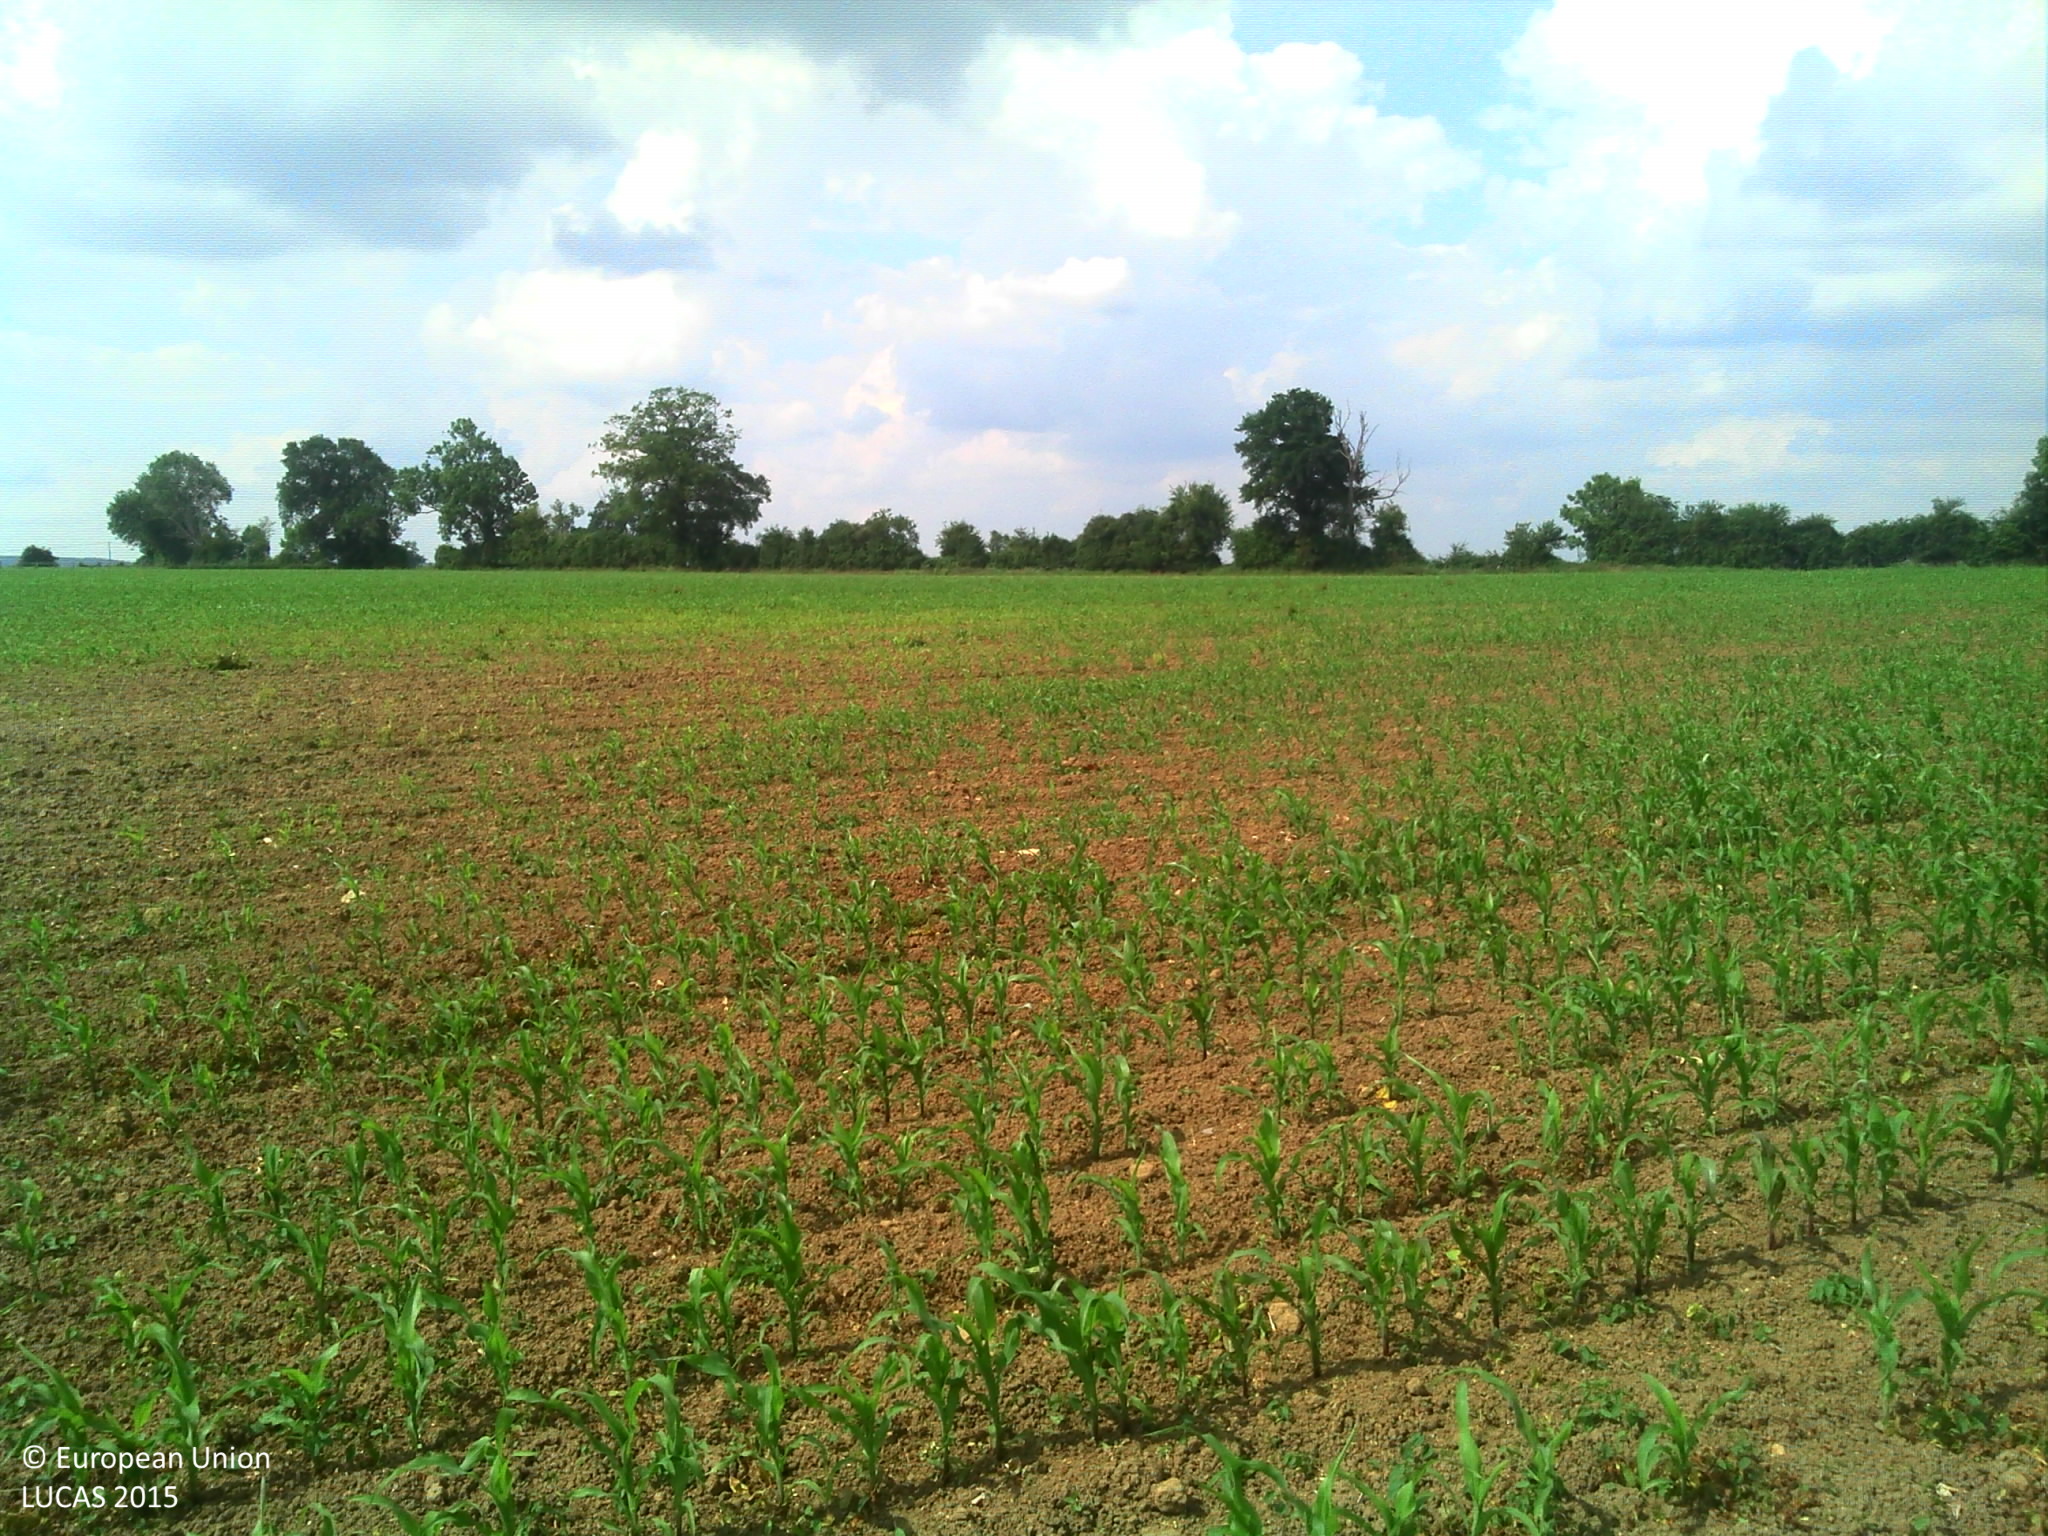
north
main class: Cropland
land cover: Maize
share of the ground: 10 - 25 %
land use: Agriculture (excluding fallow land and kitchen gardens)
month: June
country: FR
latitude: 48.4692
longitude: 0.1388
